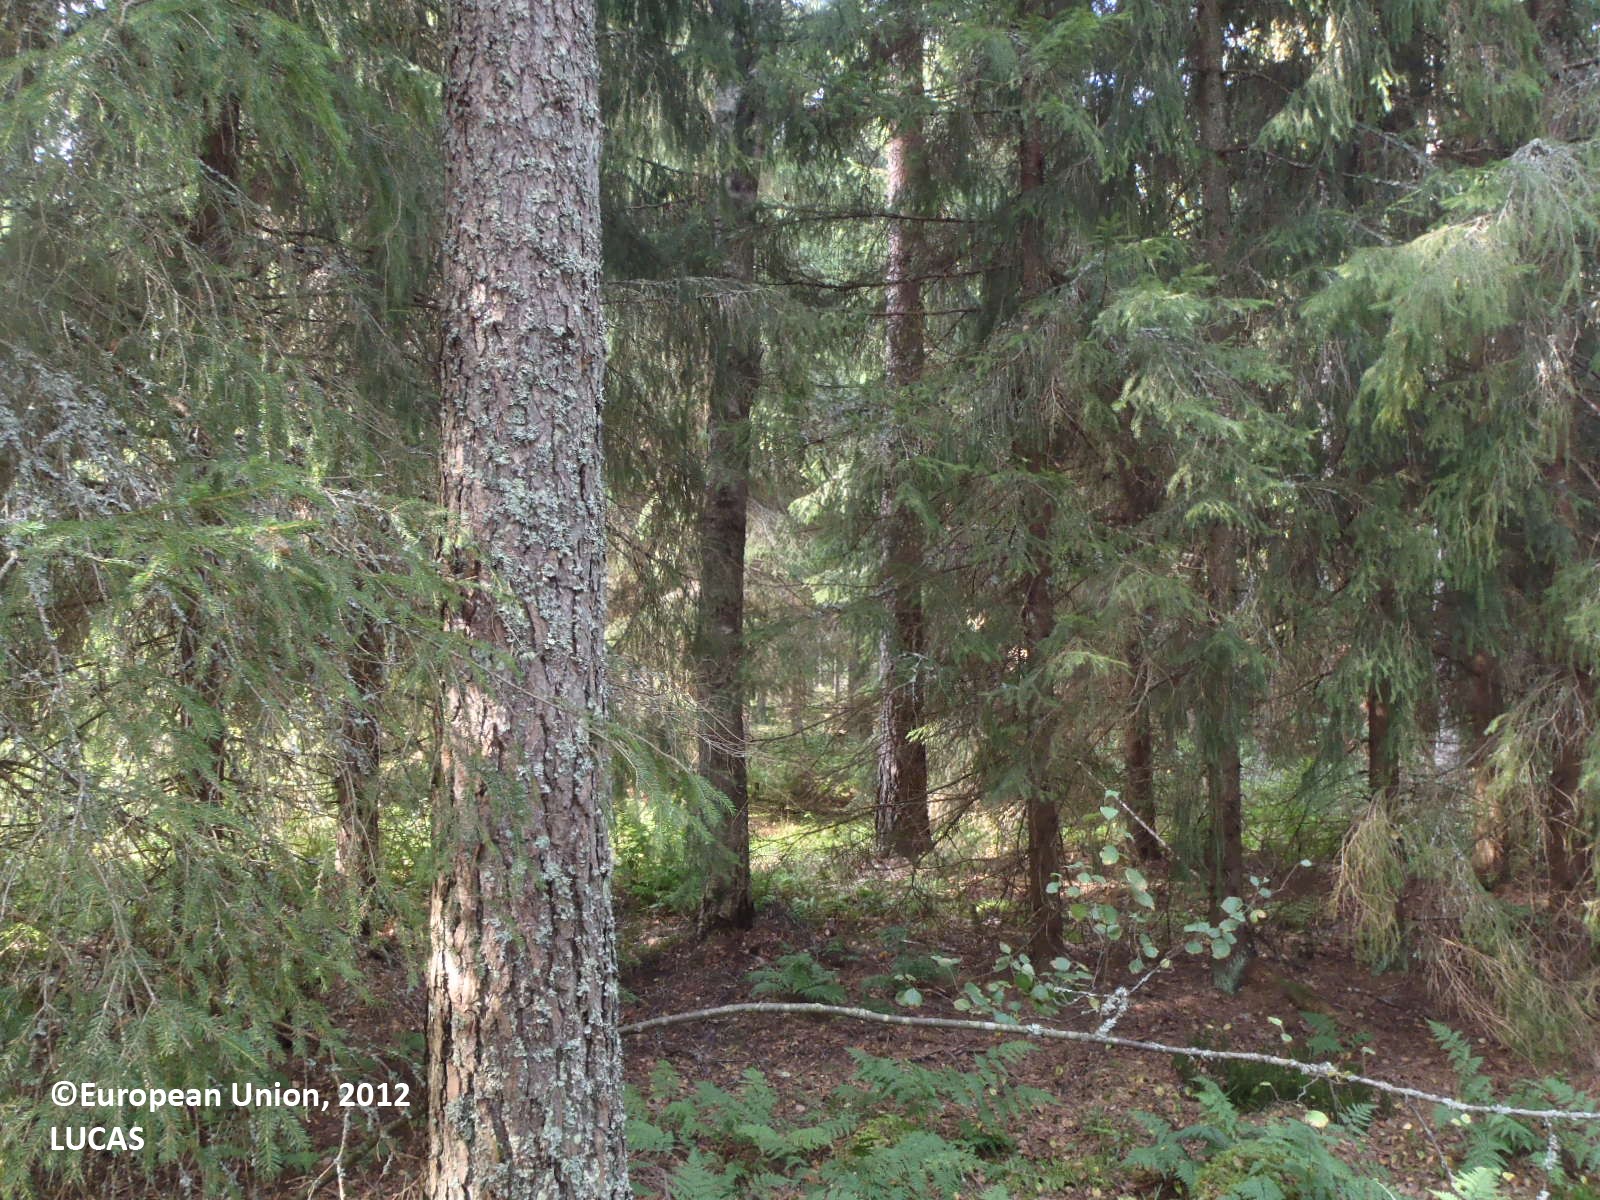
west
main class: Woodland
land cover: Other mixed woodland
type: boreal forest
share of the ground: > 75 %
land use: Forestry
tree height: > 5 m
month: August
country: FI
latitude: 60.7563
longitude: 22.2683
